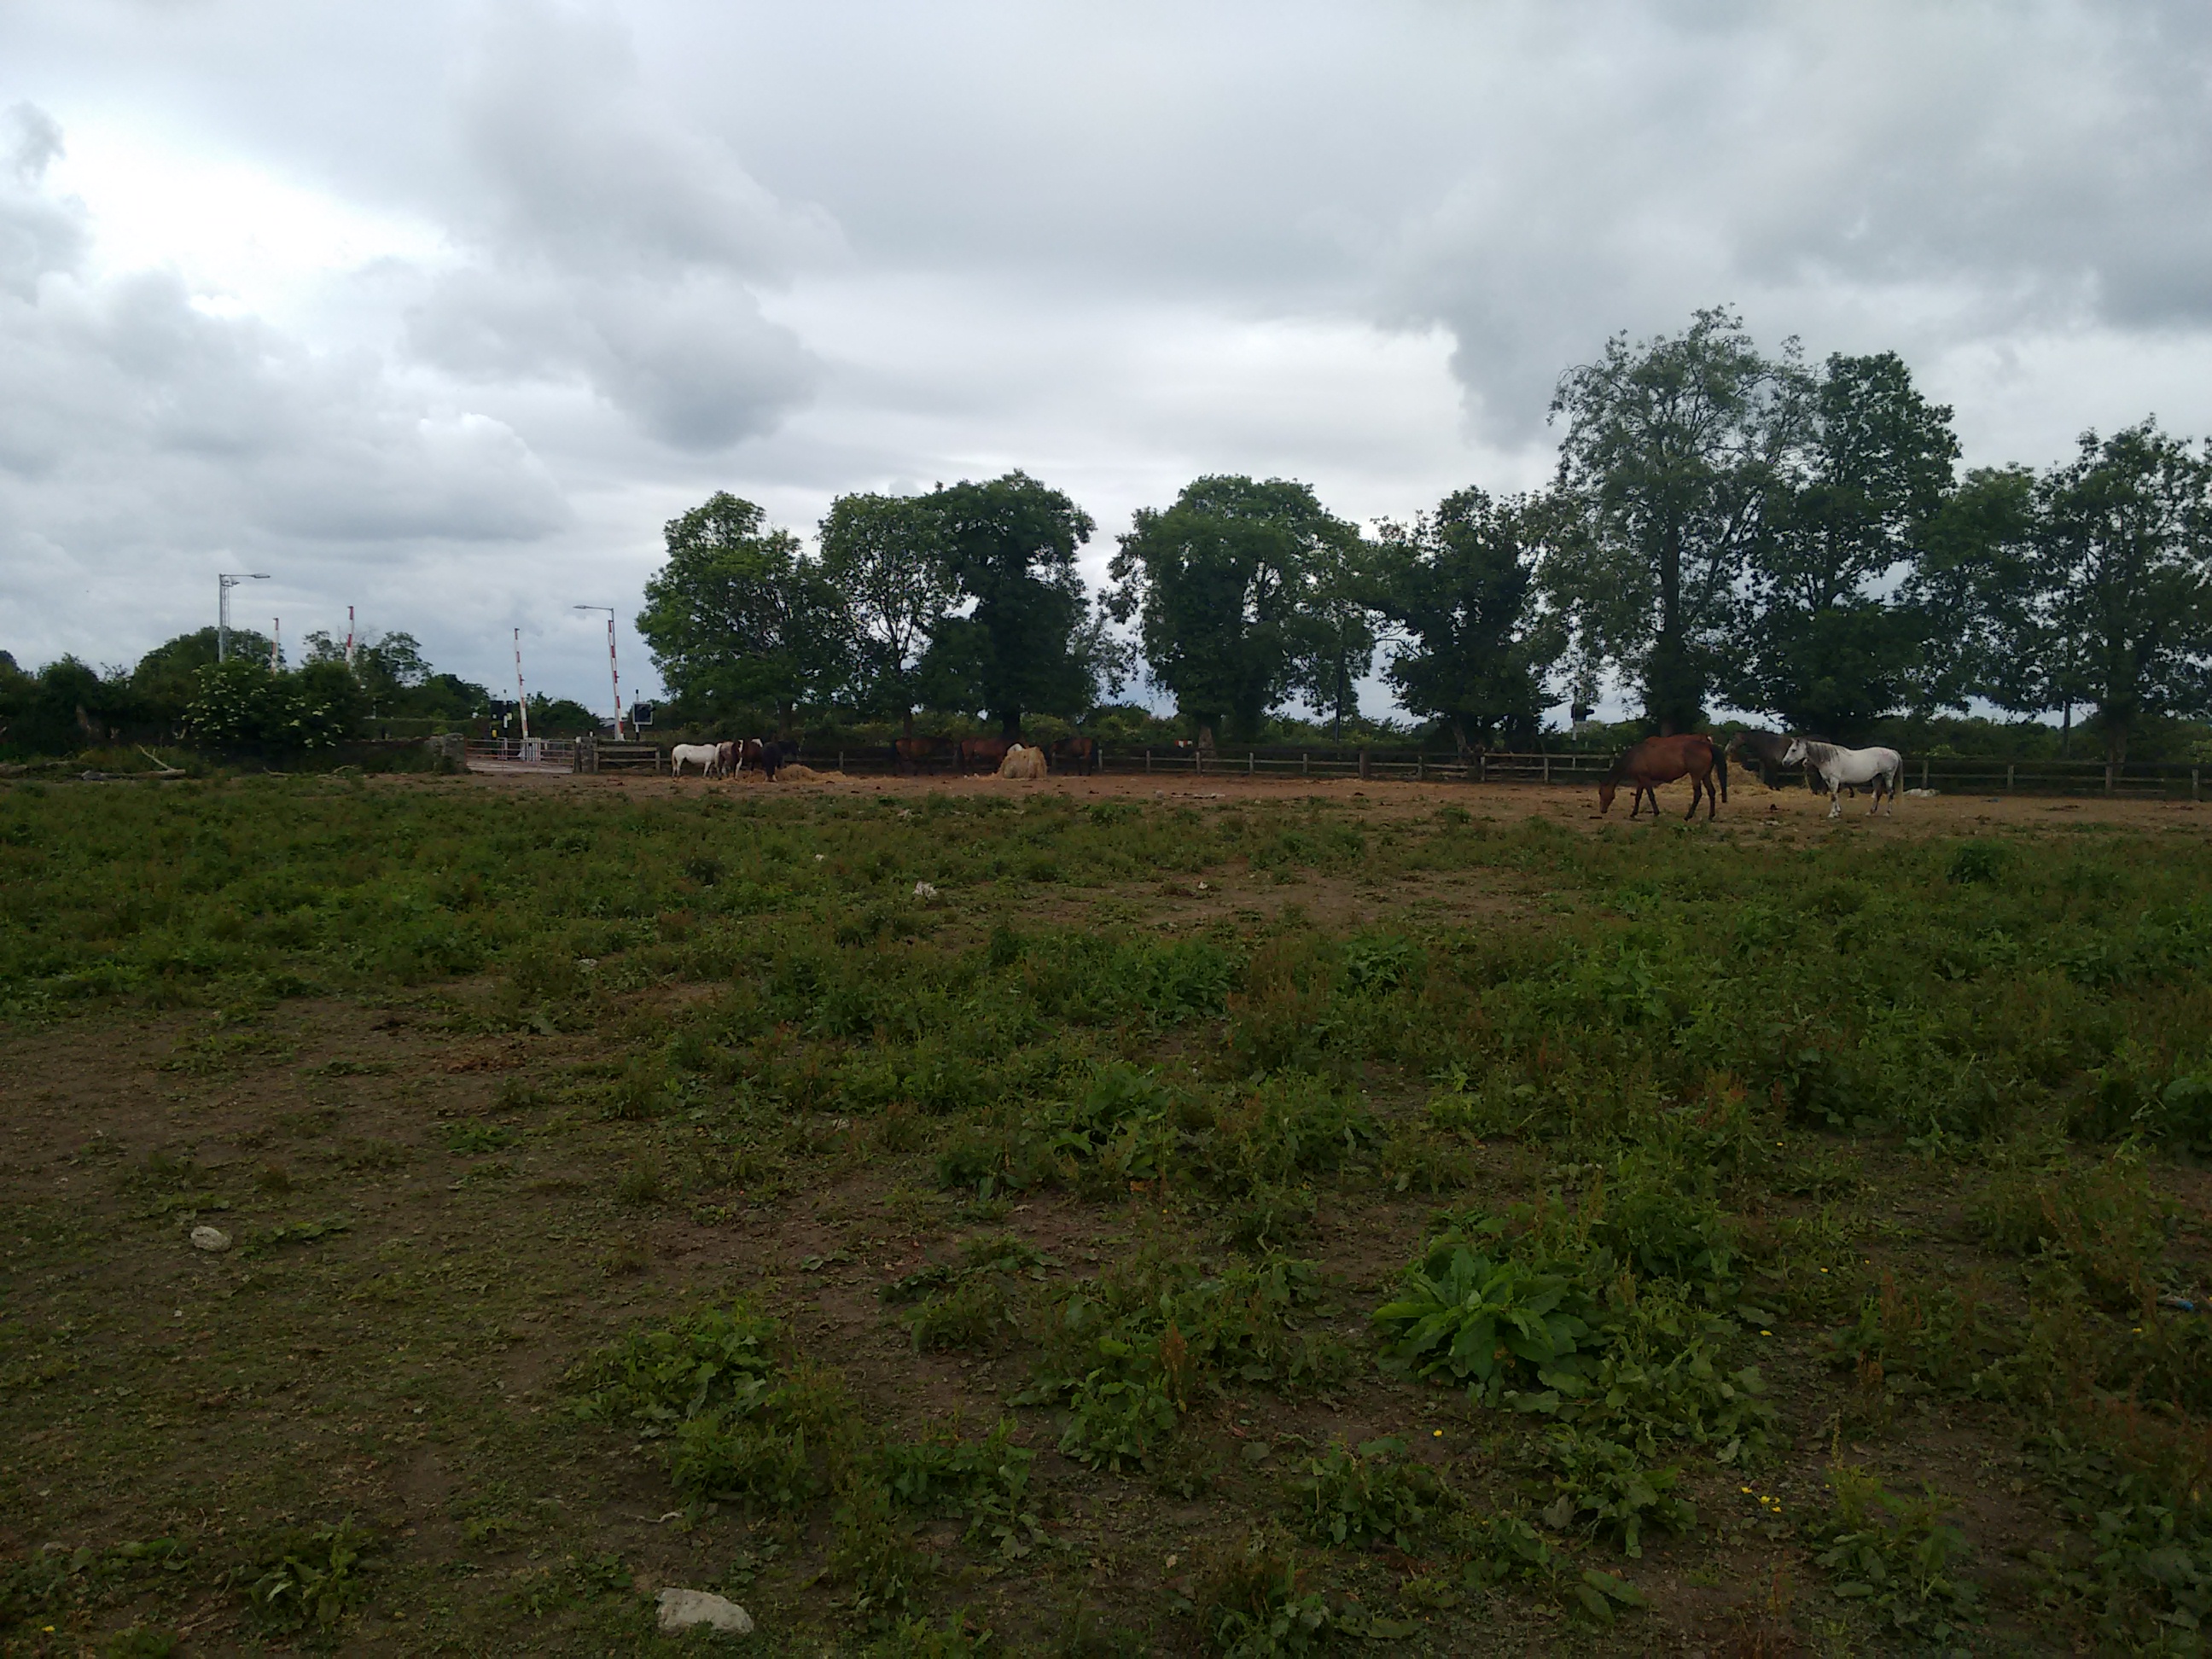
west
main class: Grassland
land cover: Spontaneously vegetated surfaces
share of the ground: > 75 %
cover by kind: herbaceous plants 50 %, consolidated bare surface 45 %, shrubs 5 %
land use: Agriculture (excluding fallow land and kitchen gardens)
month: June
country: IE
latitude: 53.4154
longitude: -7.9108
